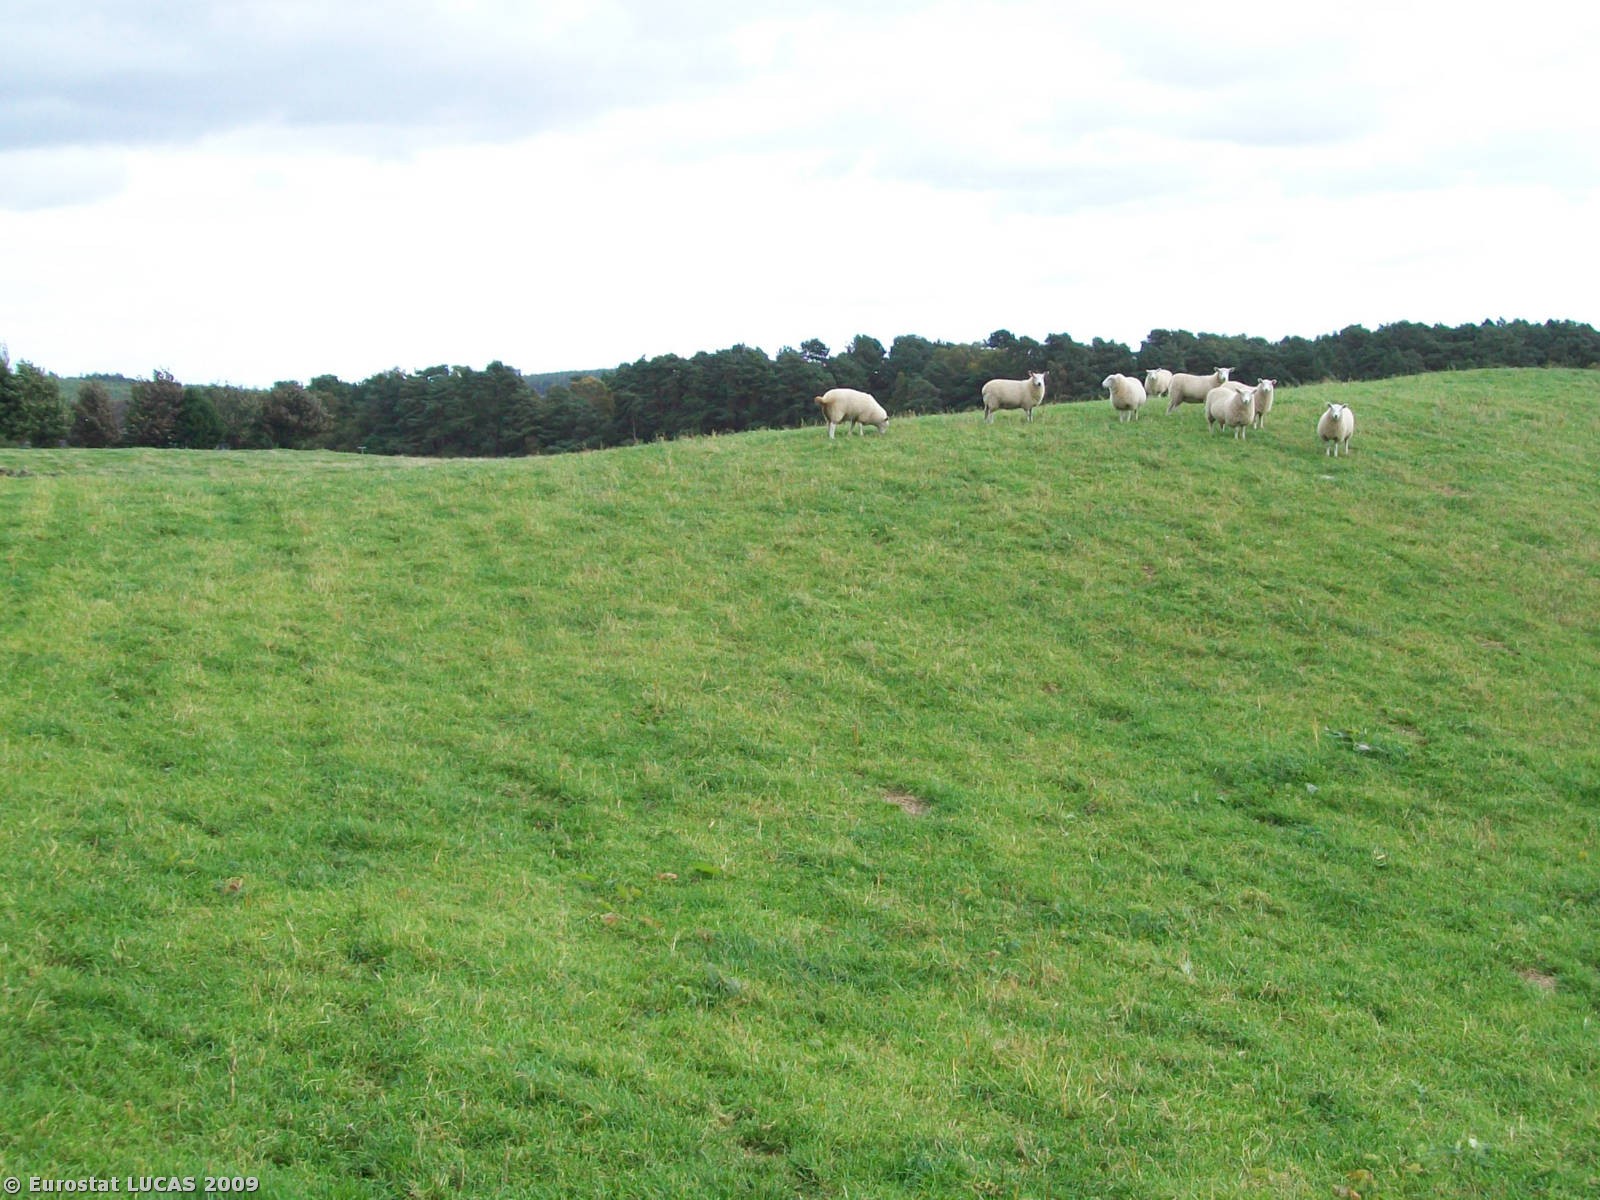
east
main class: Grassland
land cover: Grassland without tree/shrub cover
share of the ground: > 75 %
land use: Agriculture (excluding fallow land and kitchen gardens)
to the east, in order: Grassland without tree/shrub cover; Fences; Dry stone walls; Fences; Grassland without tree/shrub cover
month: September
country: GB
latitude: 57.2500
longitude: -2.5011
